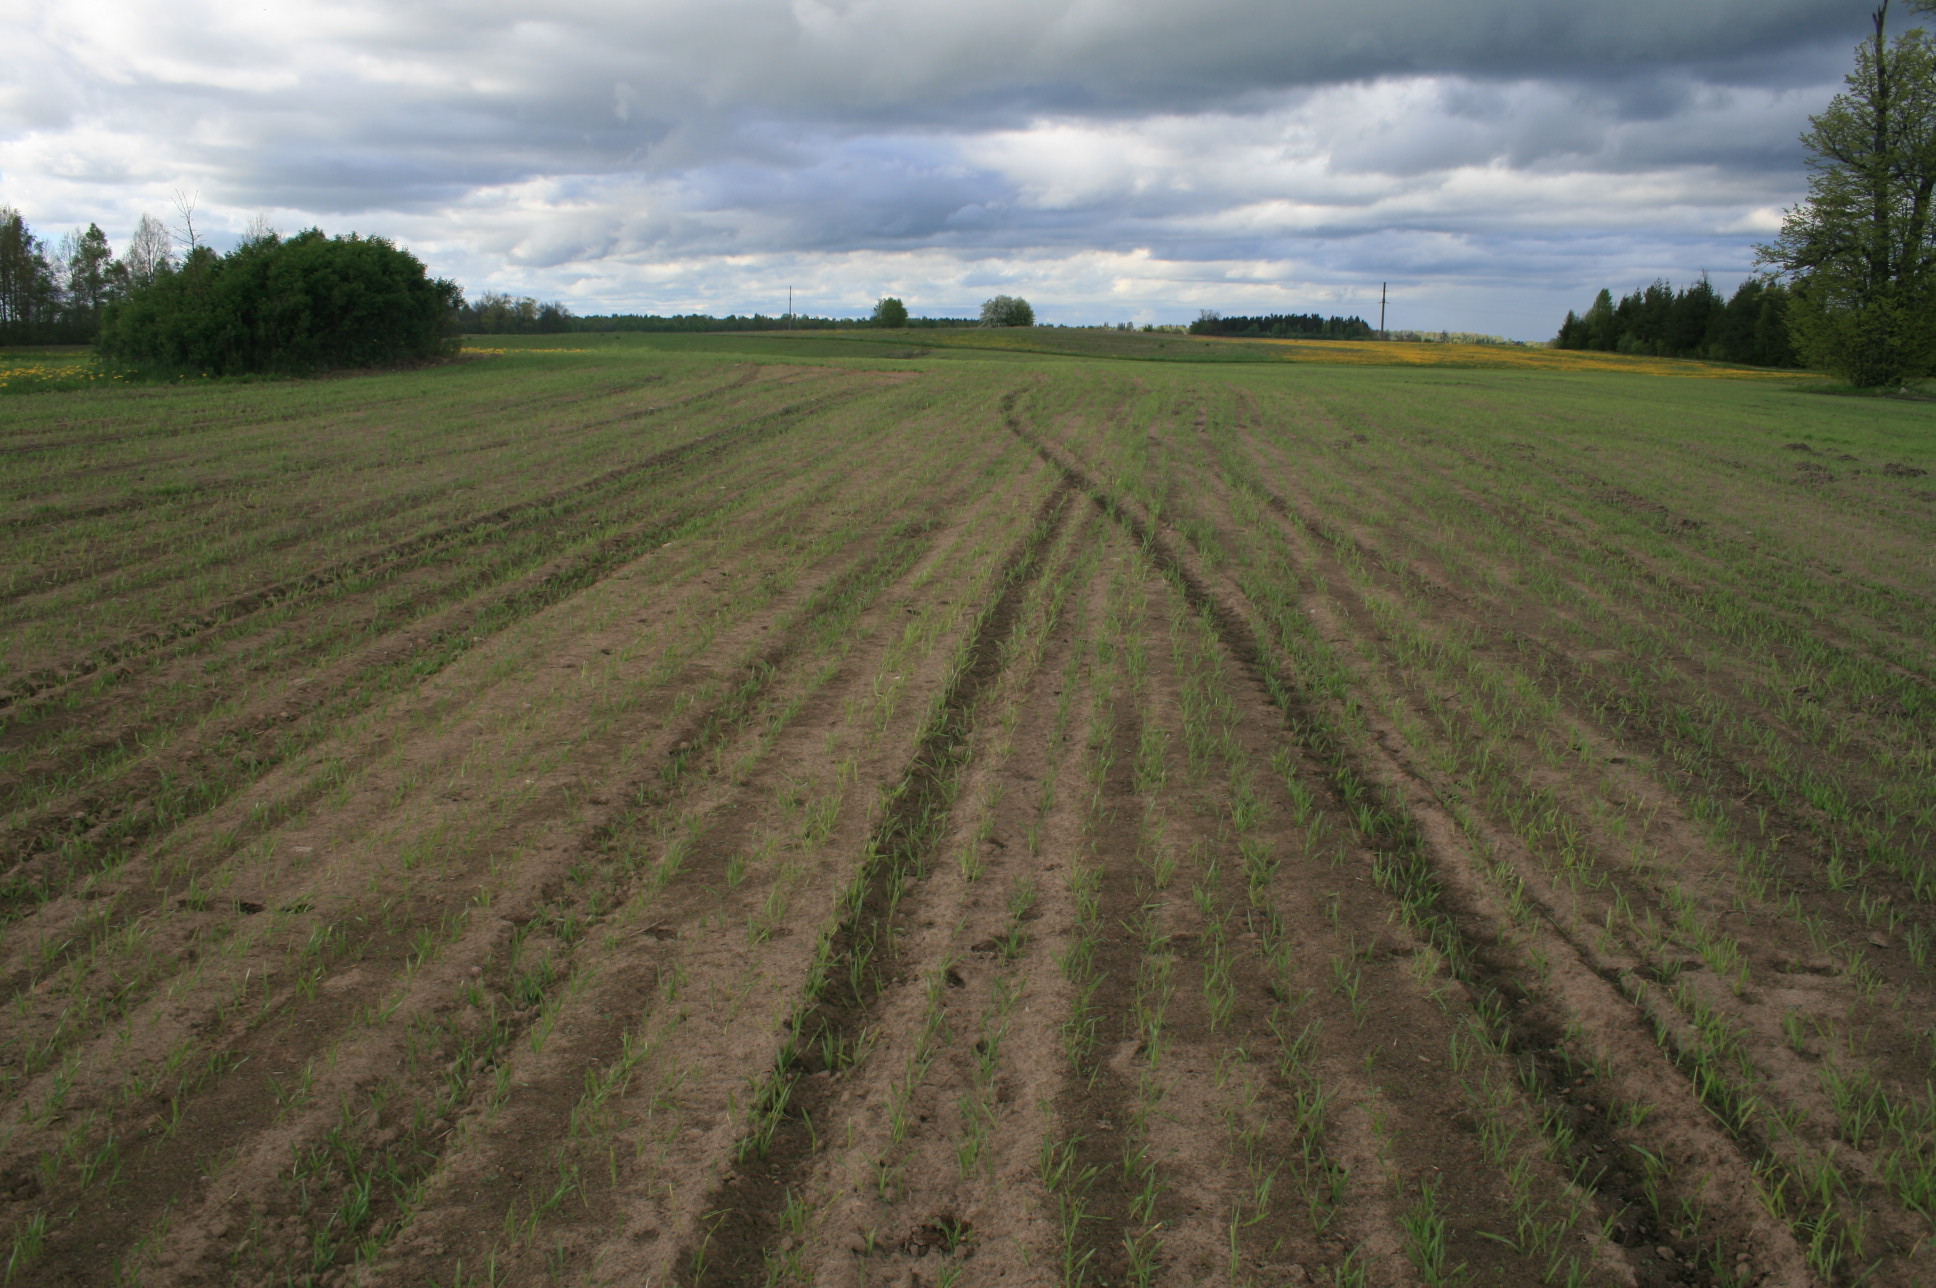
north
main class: Cropland
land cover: Barley
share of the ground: 10 - 25 %
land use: Agriculture (excluding fallow land and kitchen gardens)
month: May
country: LT
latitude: 56.1667
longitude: 22.0164
